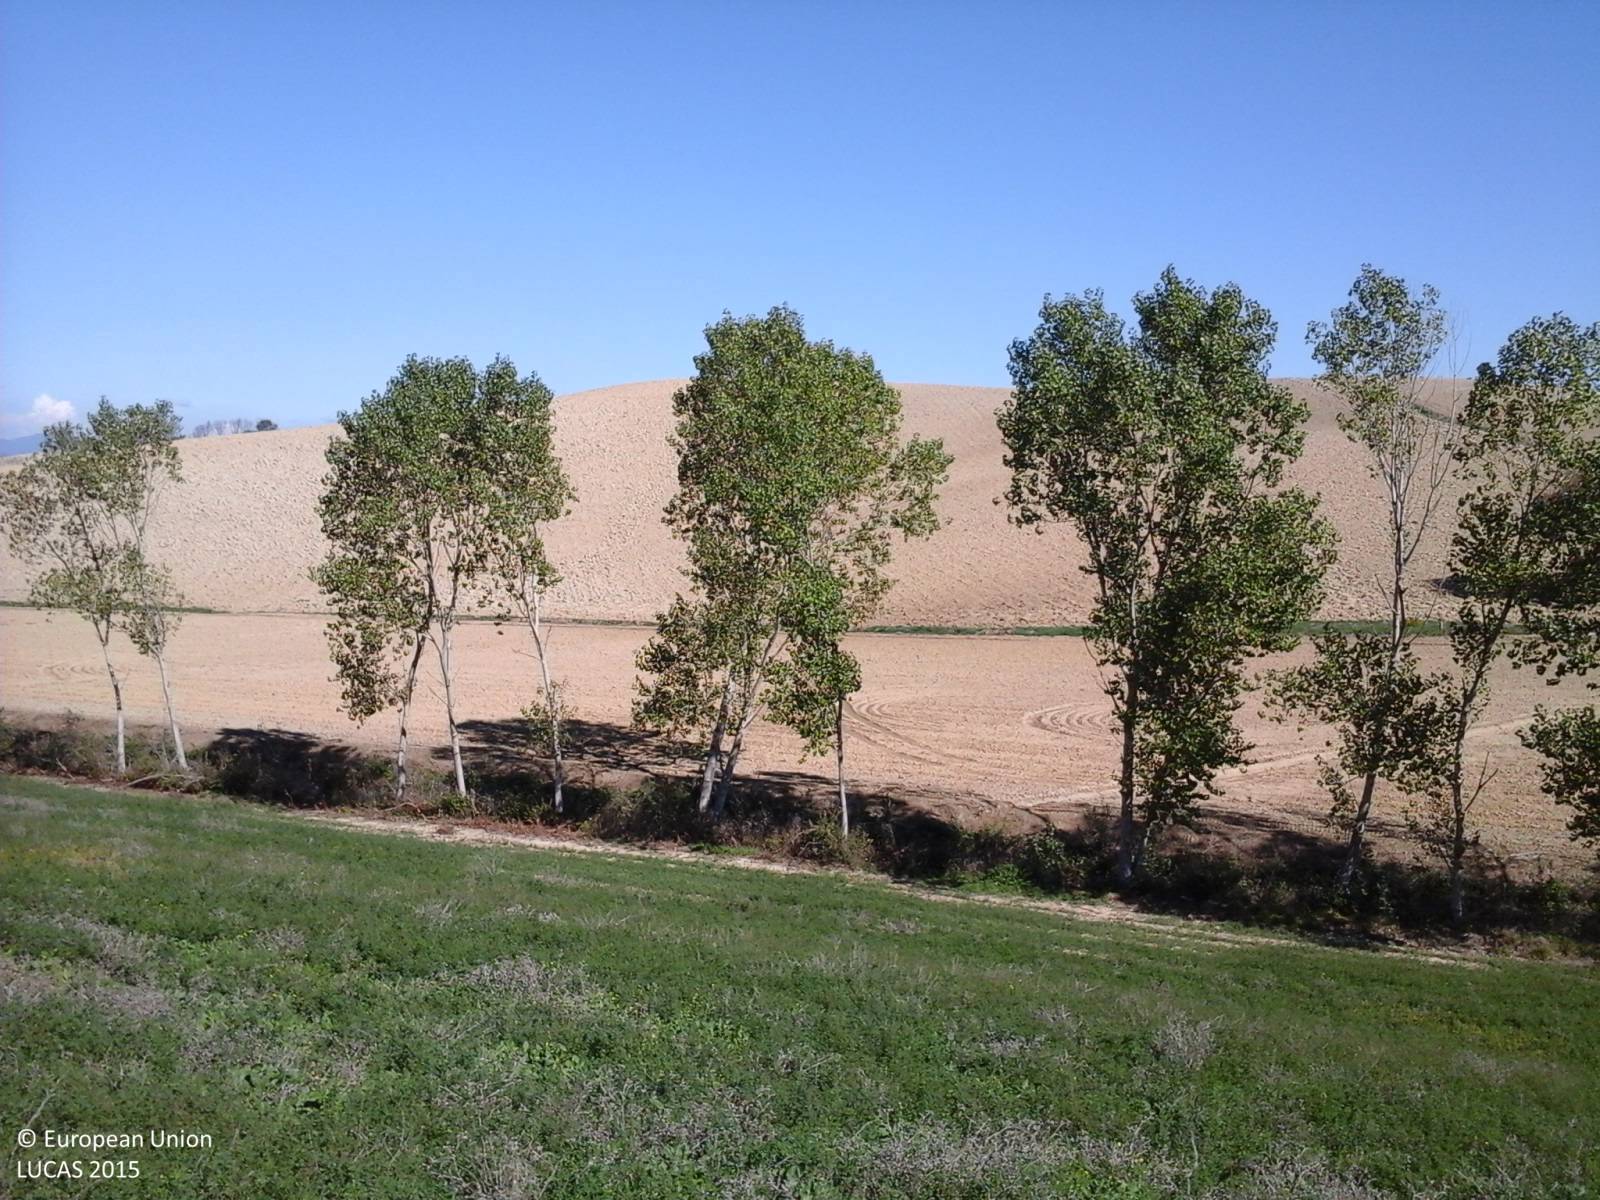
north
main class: Cropland
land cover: Lucerne
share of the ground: > 75 %
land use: Agriculture (excluding fallow land and kitchen gardens)
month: October
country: IT
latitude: 43.5013
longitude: 10.5056
